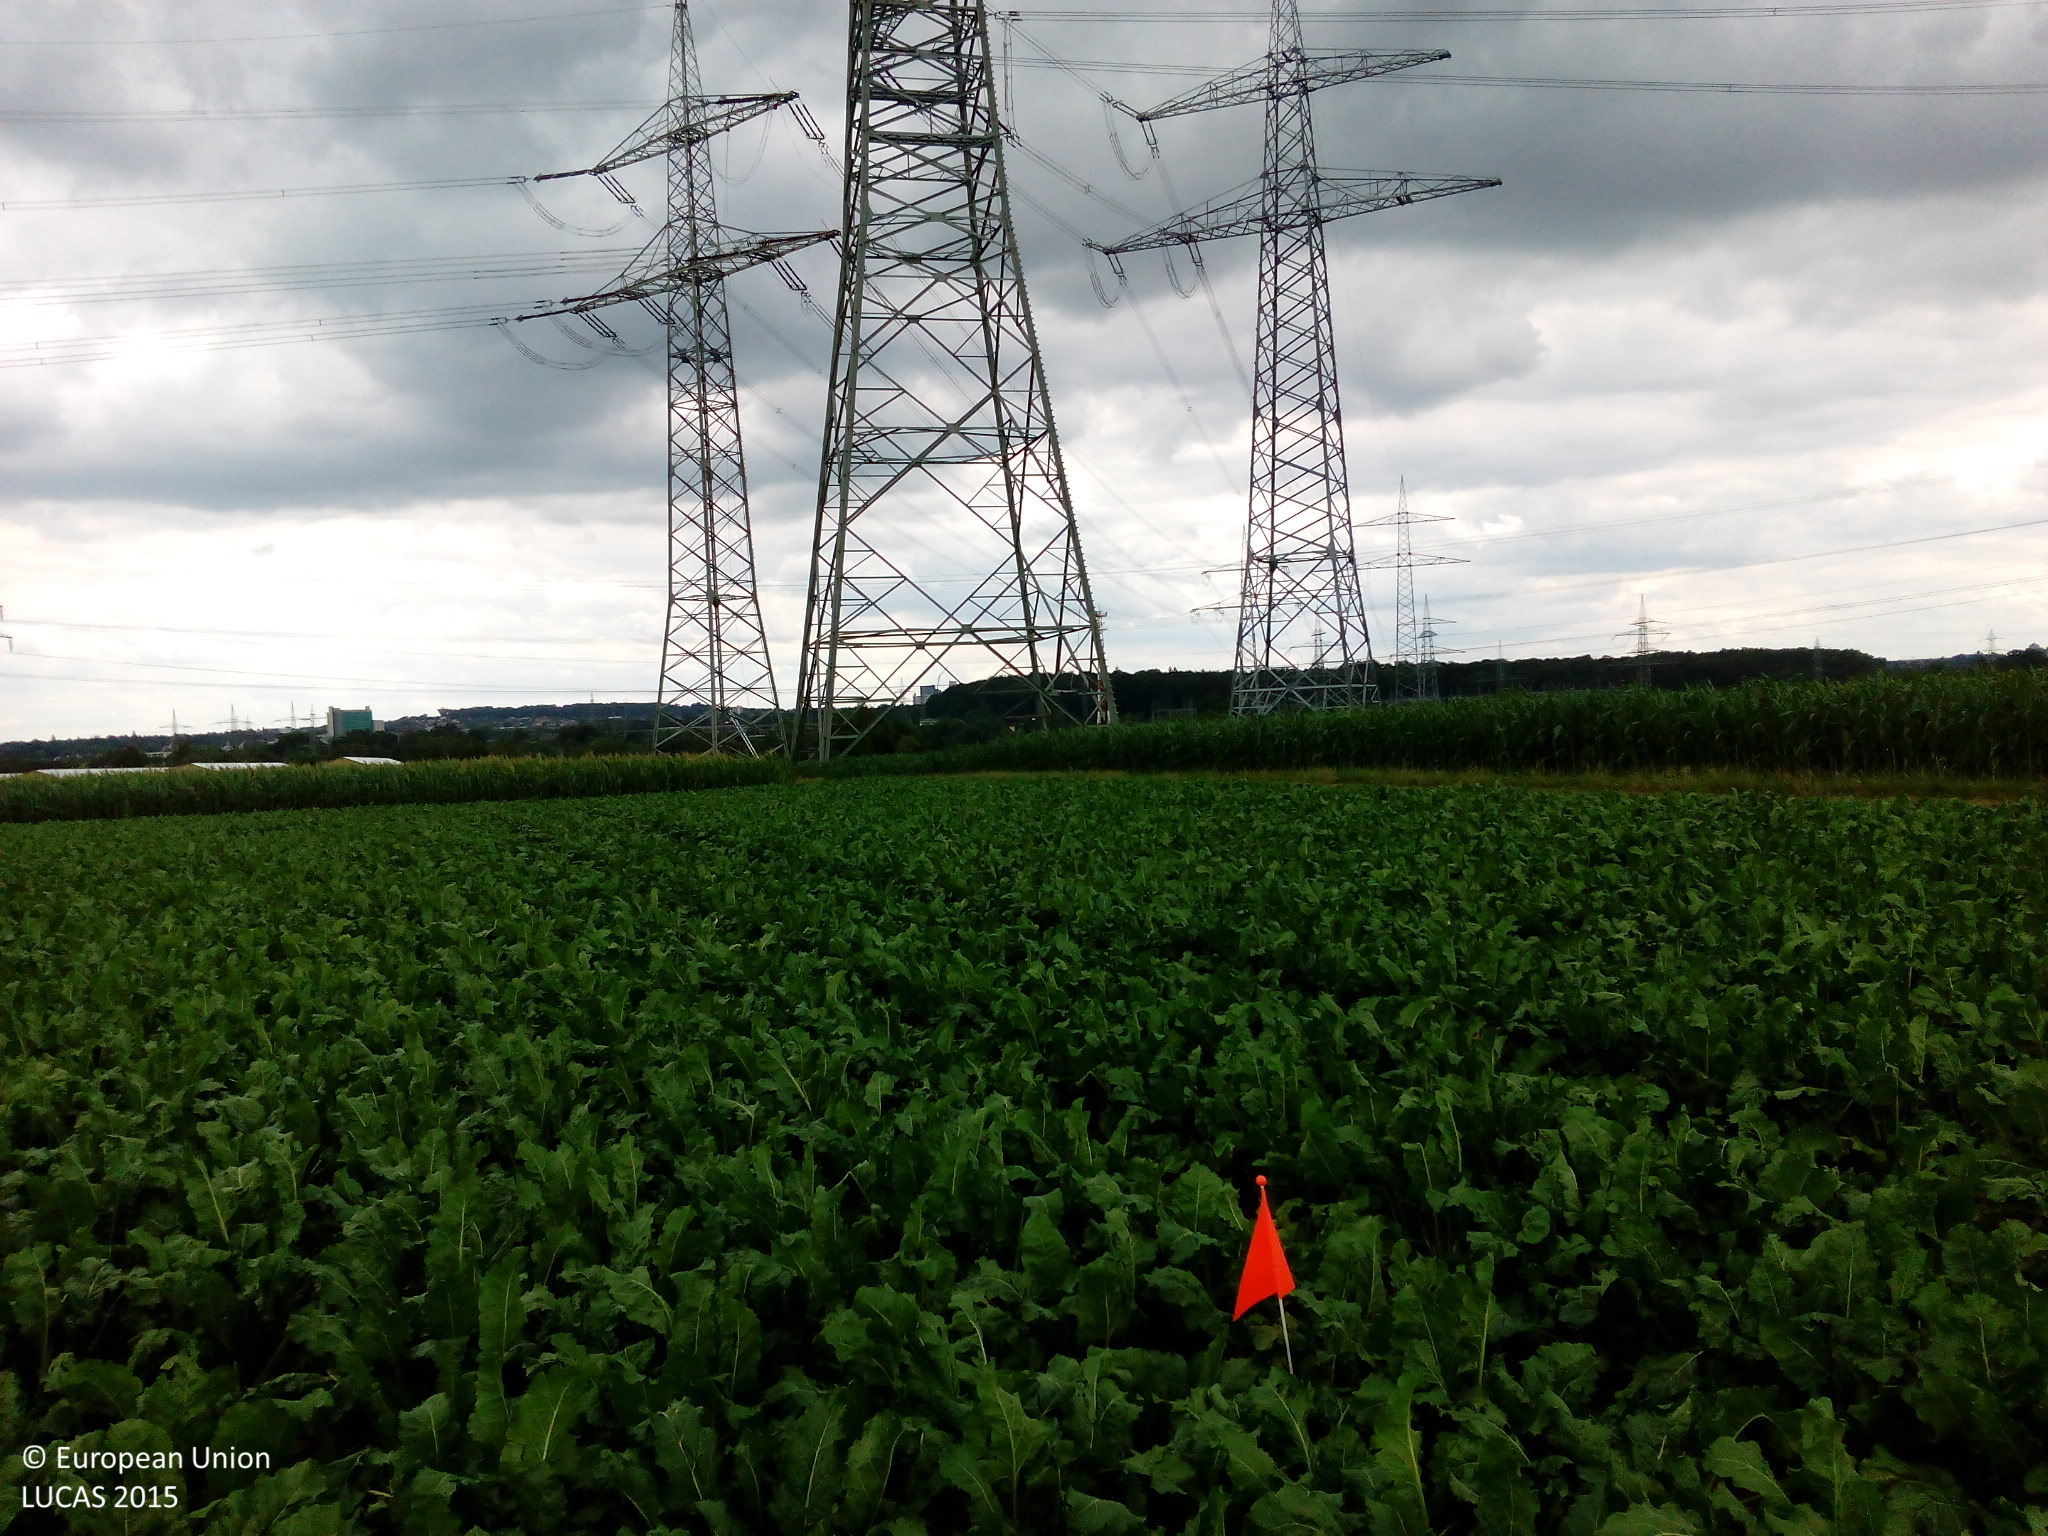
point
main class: Cropland
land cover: Sugar beet
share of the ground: > 75 %
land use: Agriculture (excluding fallow land and kitchen gardens)
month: July
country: DE
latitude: 48.9223
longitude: 9.1952
